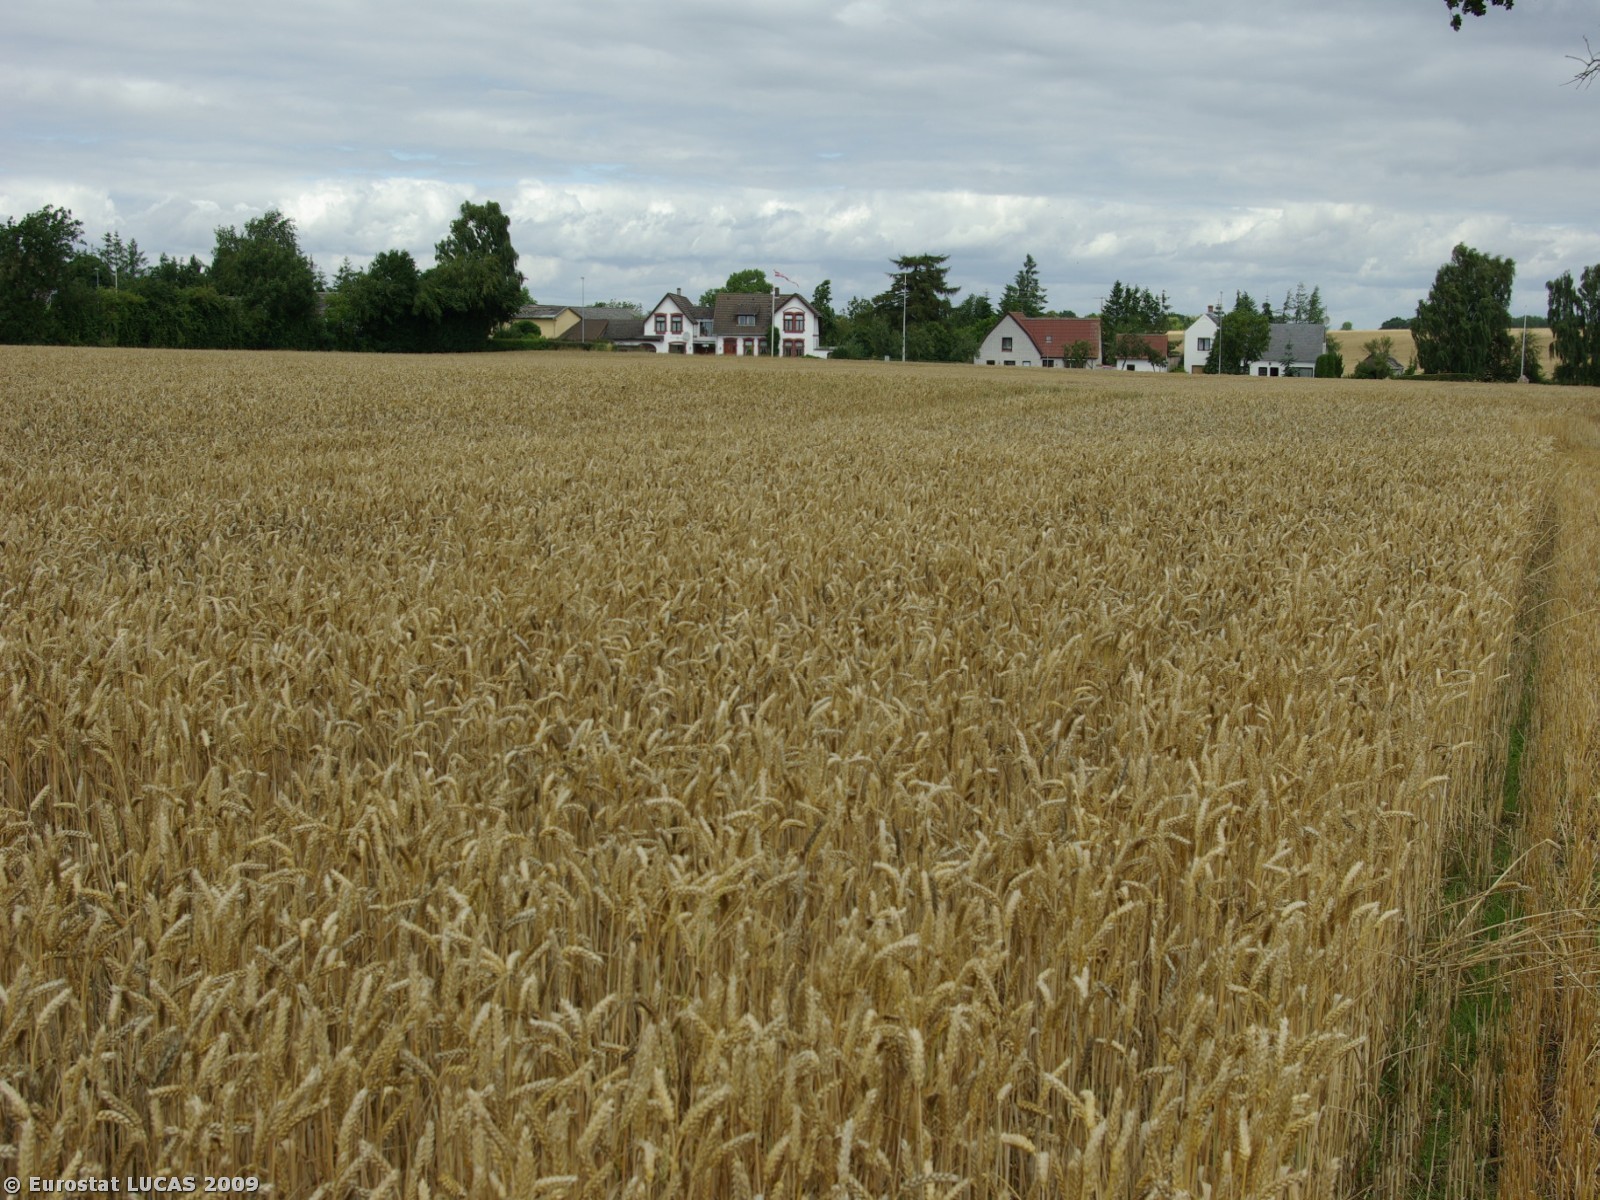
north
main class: Cropland
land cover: Common wheat
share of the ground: > 75 %
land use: Agriculture (excluding fallow land and kitchen gardens)
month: July
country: DK
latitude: 55.2526
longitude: 9.6699
